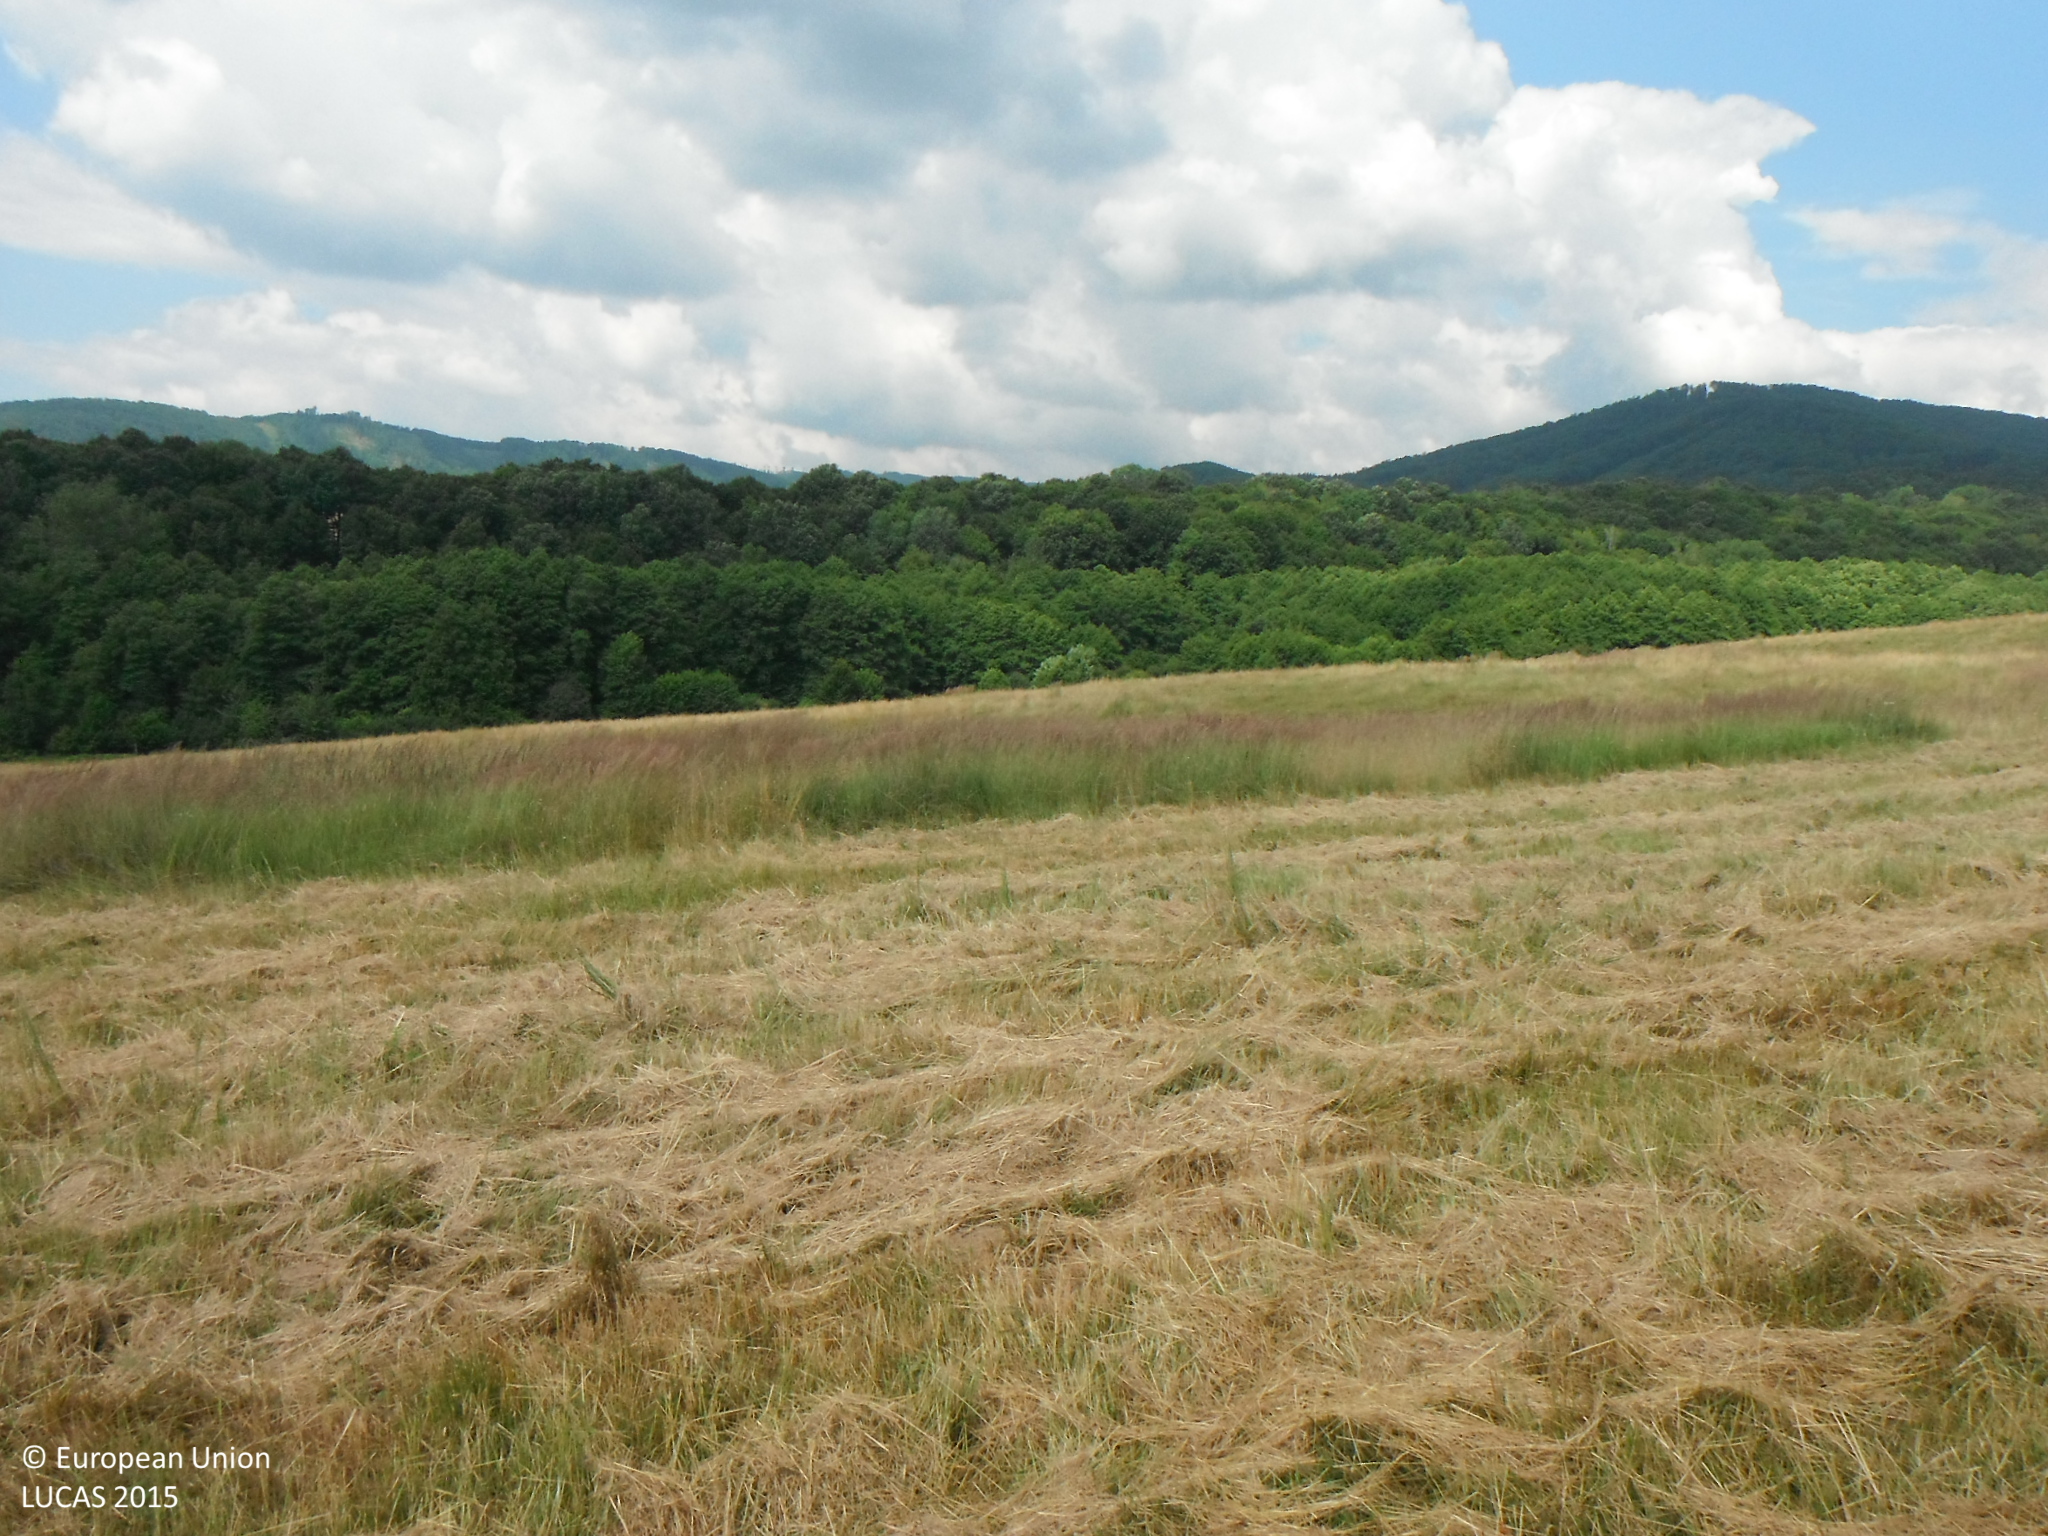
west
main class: Grassland
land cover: Grassland without tree/shrub cover
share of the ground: > 75 %
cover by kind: herbaceous plants 100 %
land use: Agriculture (excluding fallow land and kitchen gardens)
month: June
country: SK
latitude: 48.5178
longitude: 19.9255
